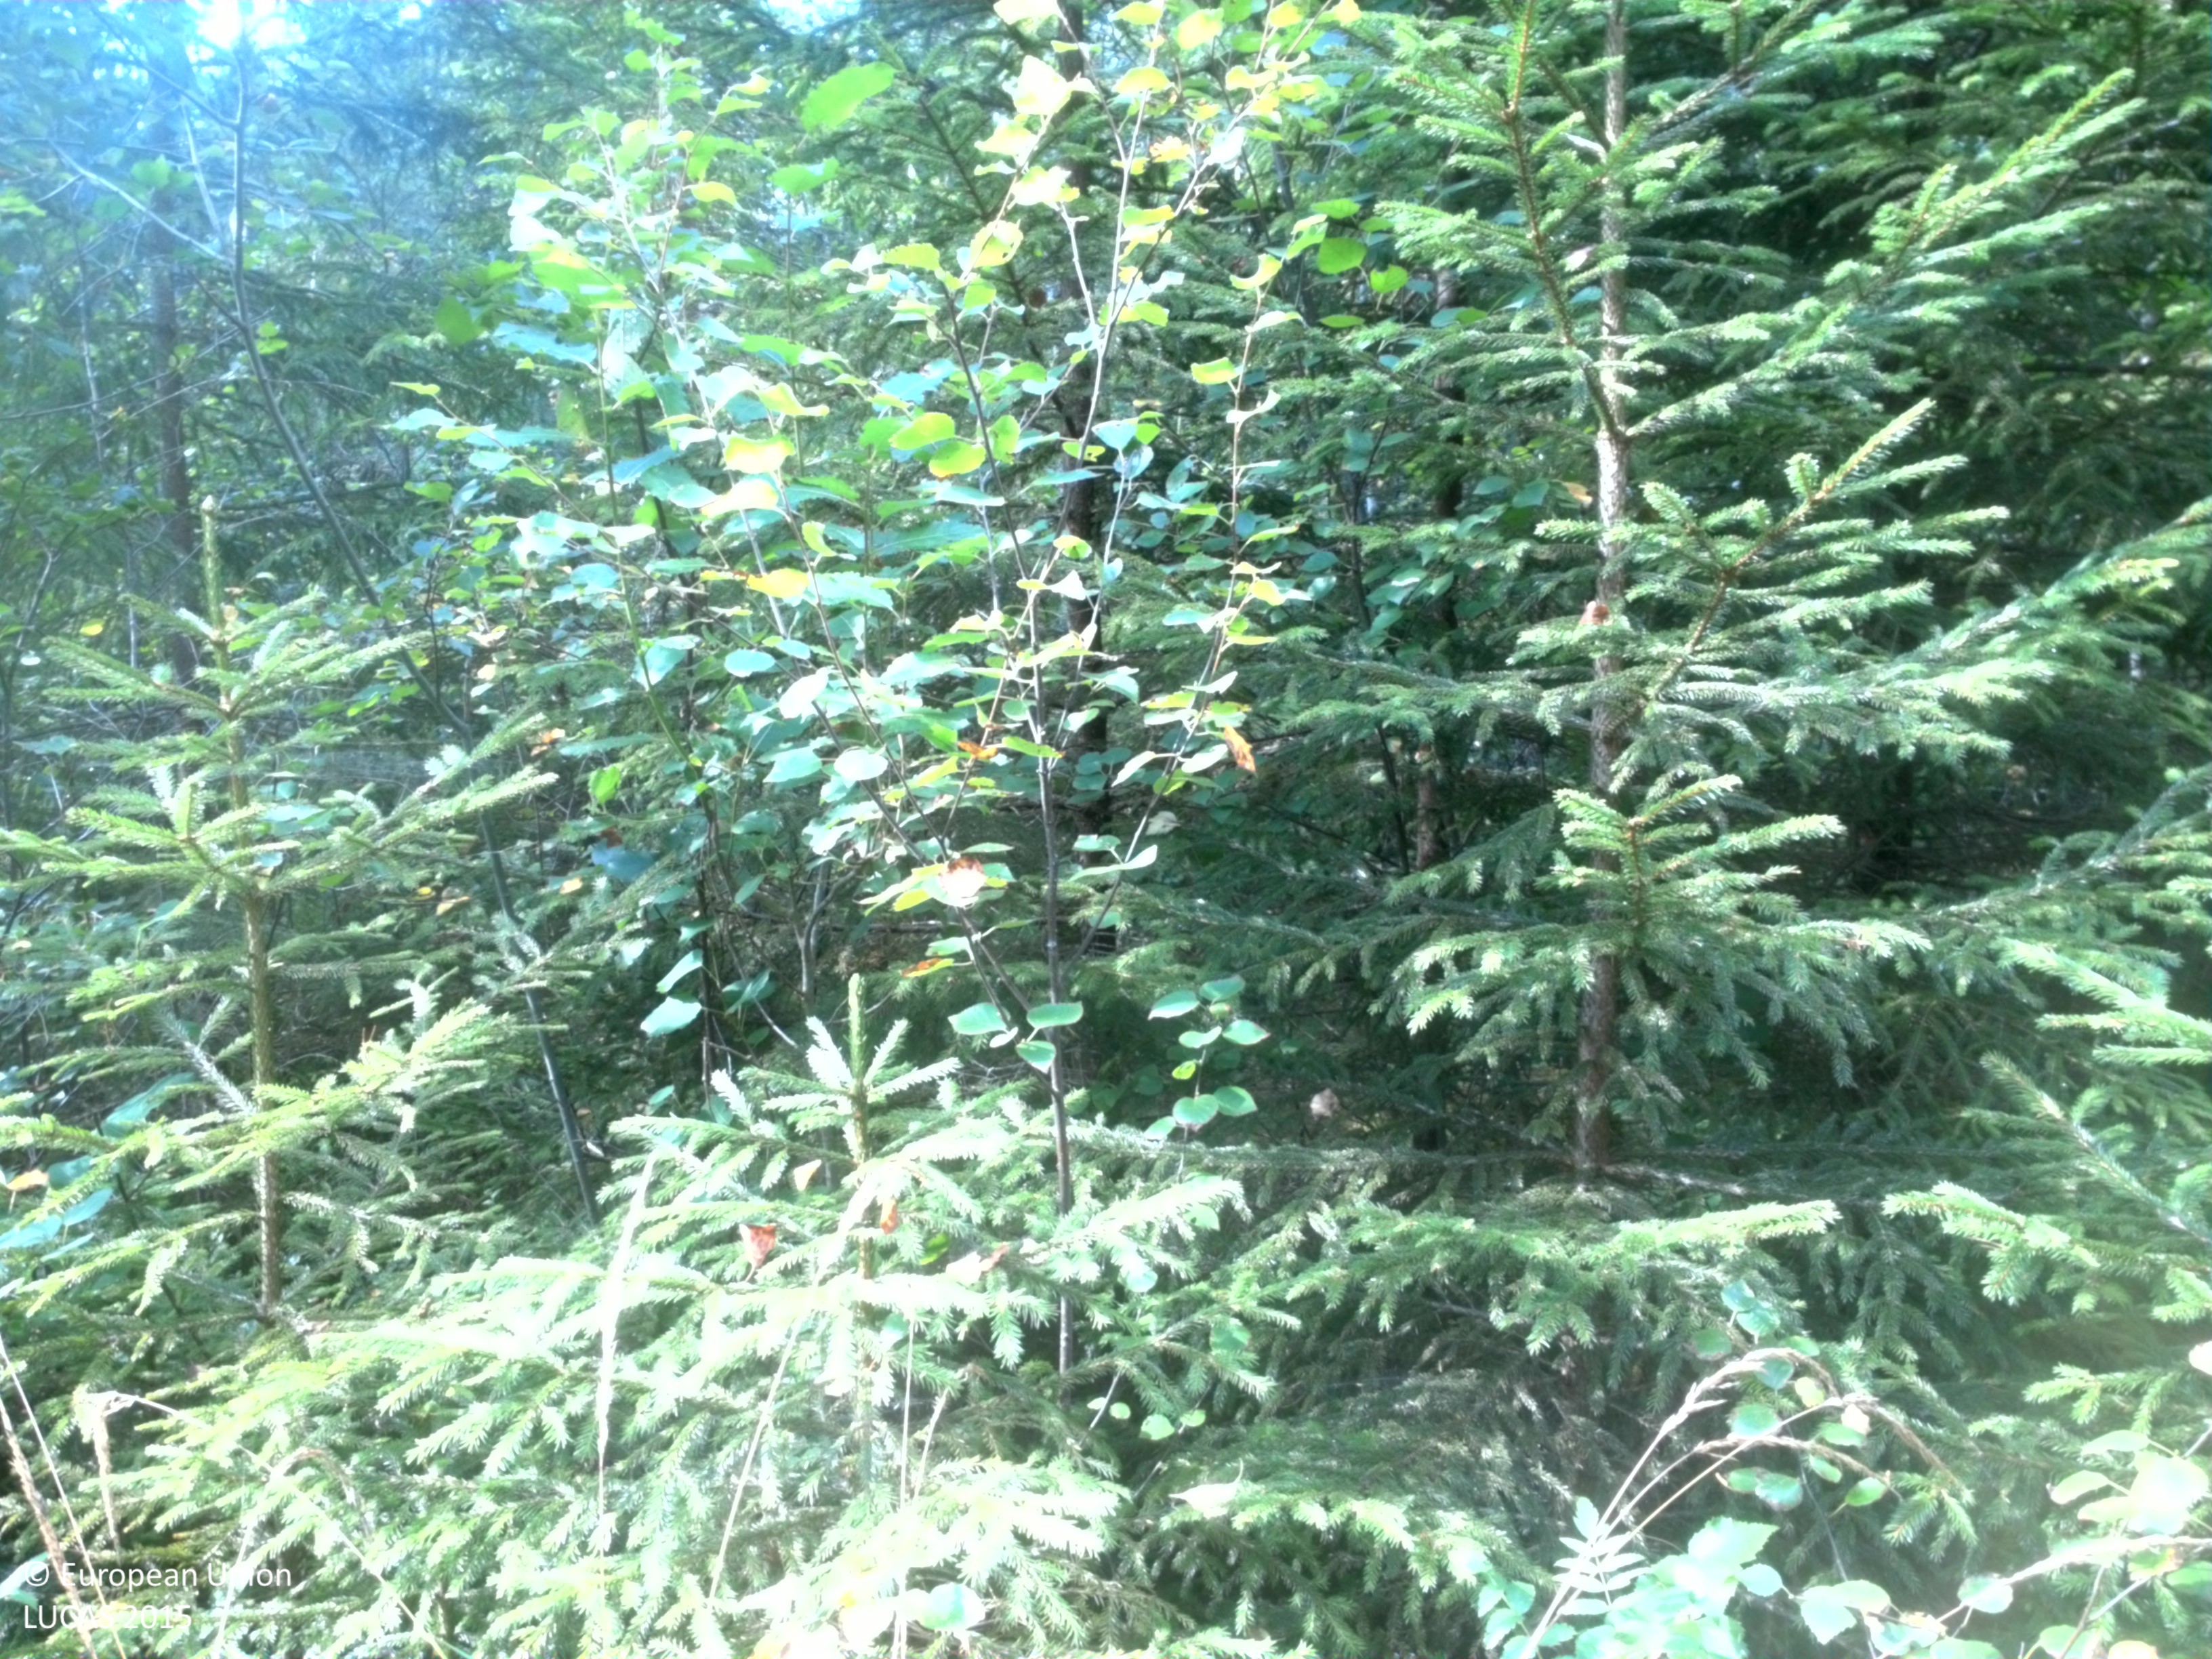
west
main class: Woodland
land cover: Spruce dominated mixed woodland
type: boreal forest
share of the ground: > 75 %
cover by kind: coniferous forest trees 50 %, broadleaved forest trees 25 %, shrubs 10 %, herbaceous plants 10 %, lichens and mosses 5 %
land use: Forestry
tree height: > 5 m
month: August
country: SE
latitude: 59.7420
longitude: 15.6660
